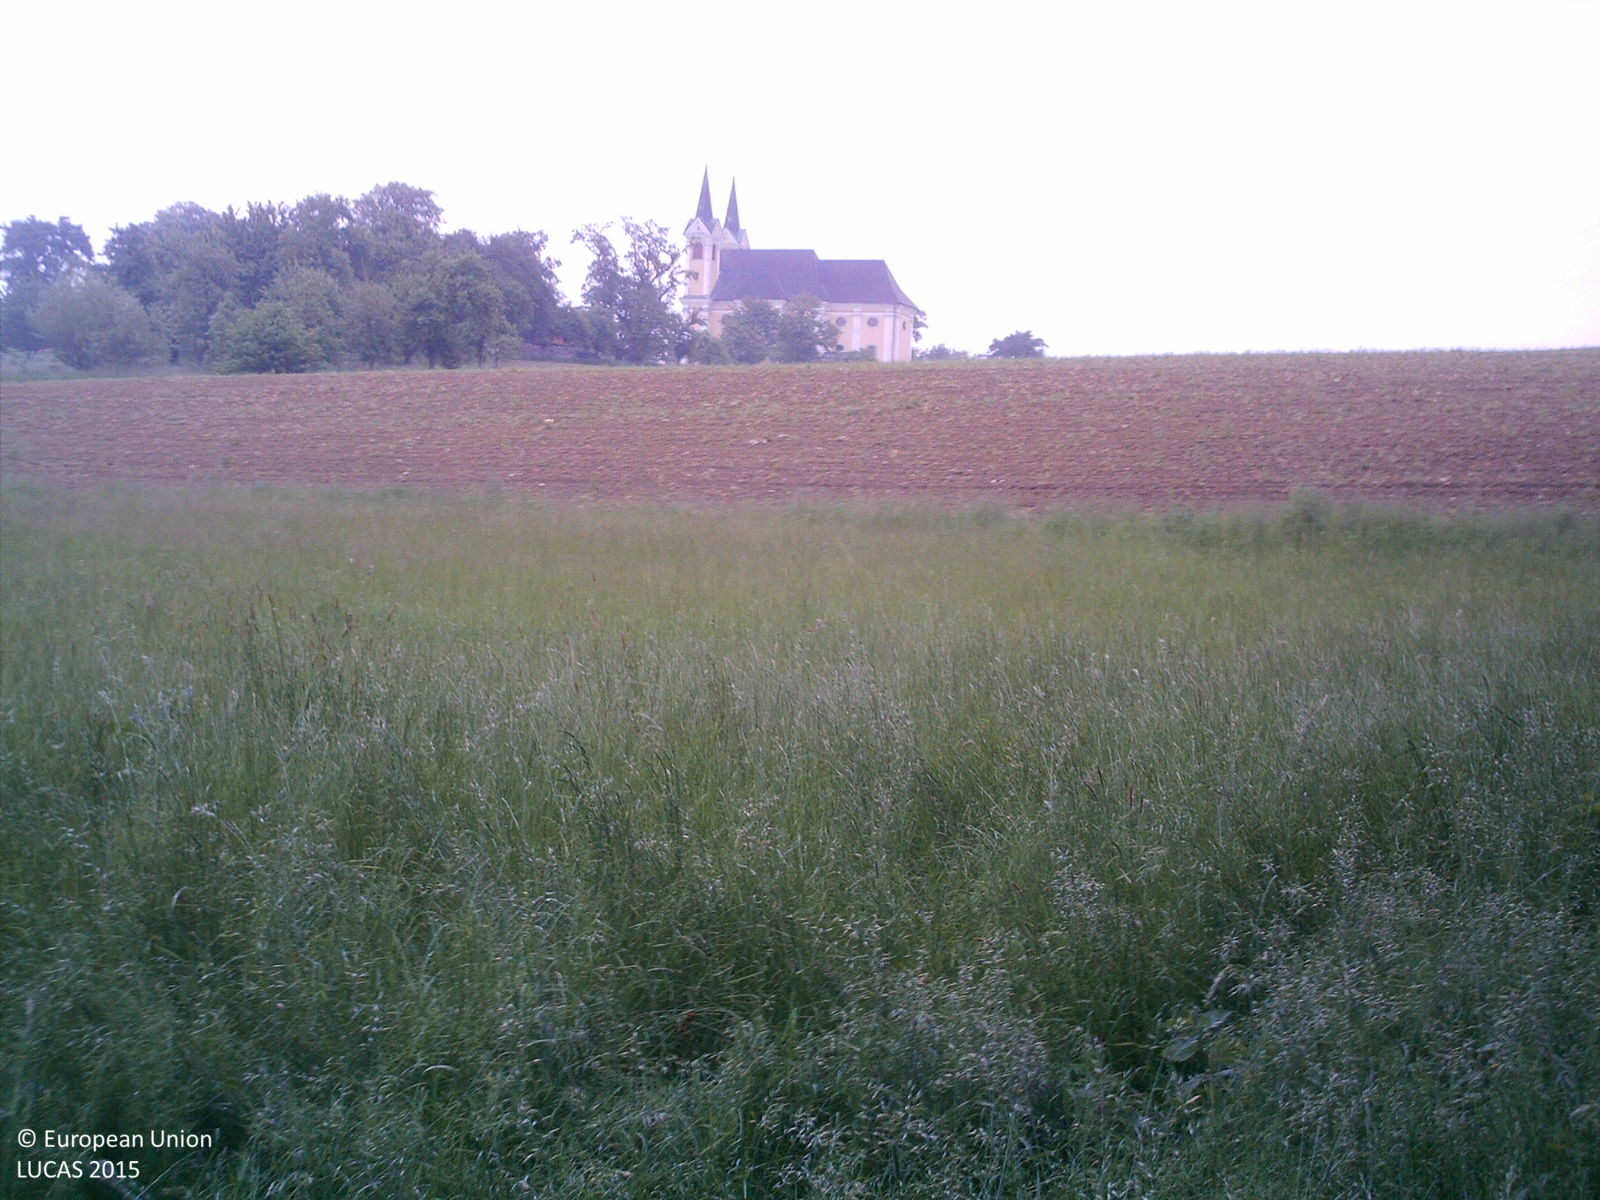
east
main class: Woodland
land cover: Broadleaved woodland
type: acidophilous oak and oak-birch forest
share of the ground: > 75 %
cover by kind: broadleaved forest trees 100 %
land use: Forestry
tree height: > 5 m
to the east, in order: Broadleaved woodland; Grassland without tree/shrub cover; Maize
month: May
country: AT
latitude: 48.0755
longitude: 14.0934
